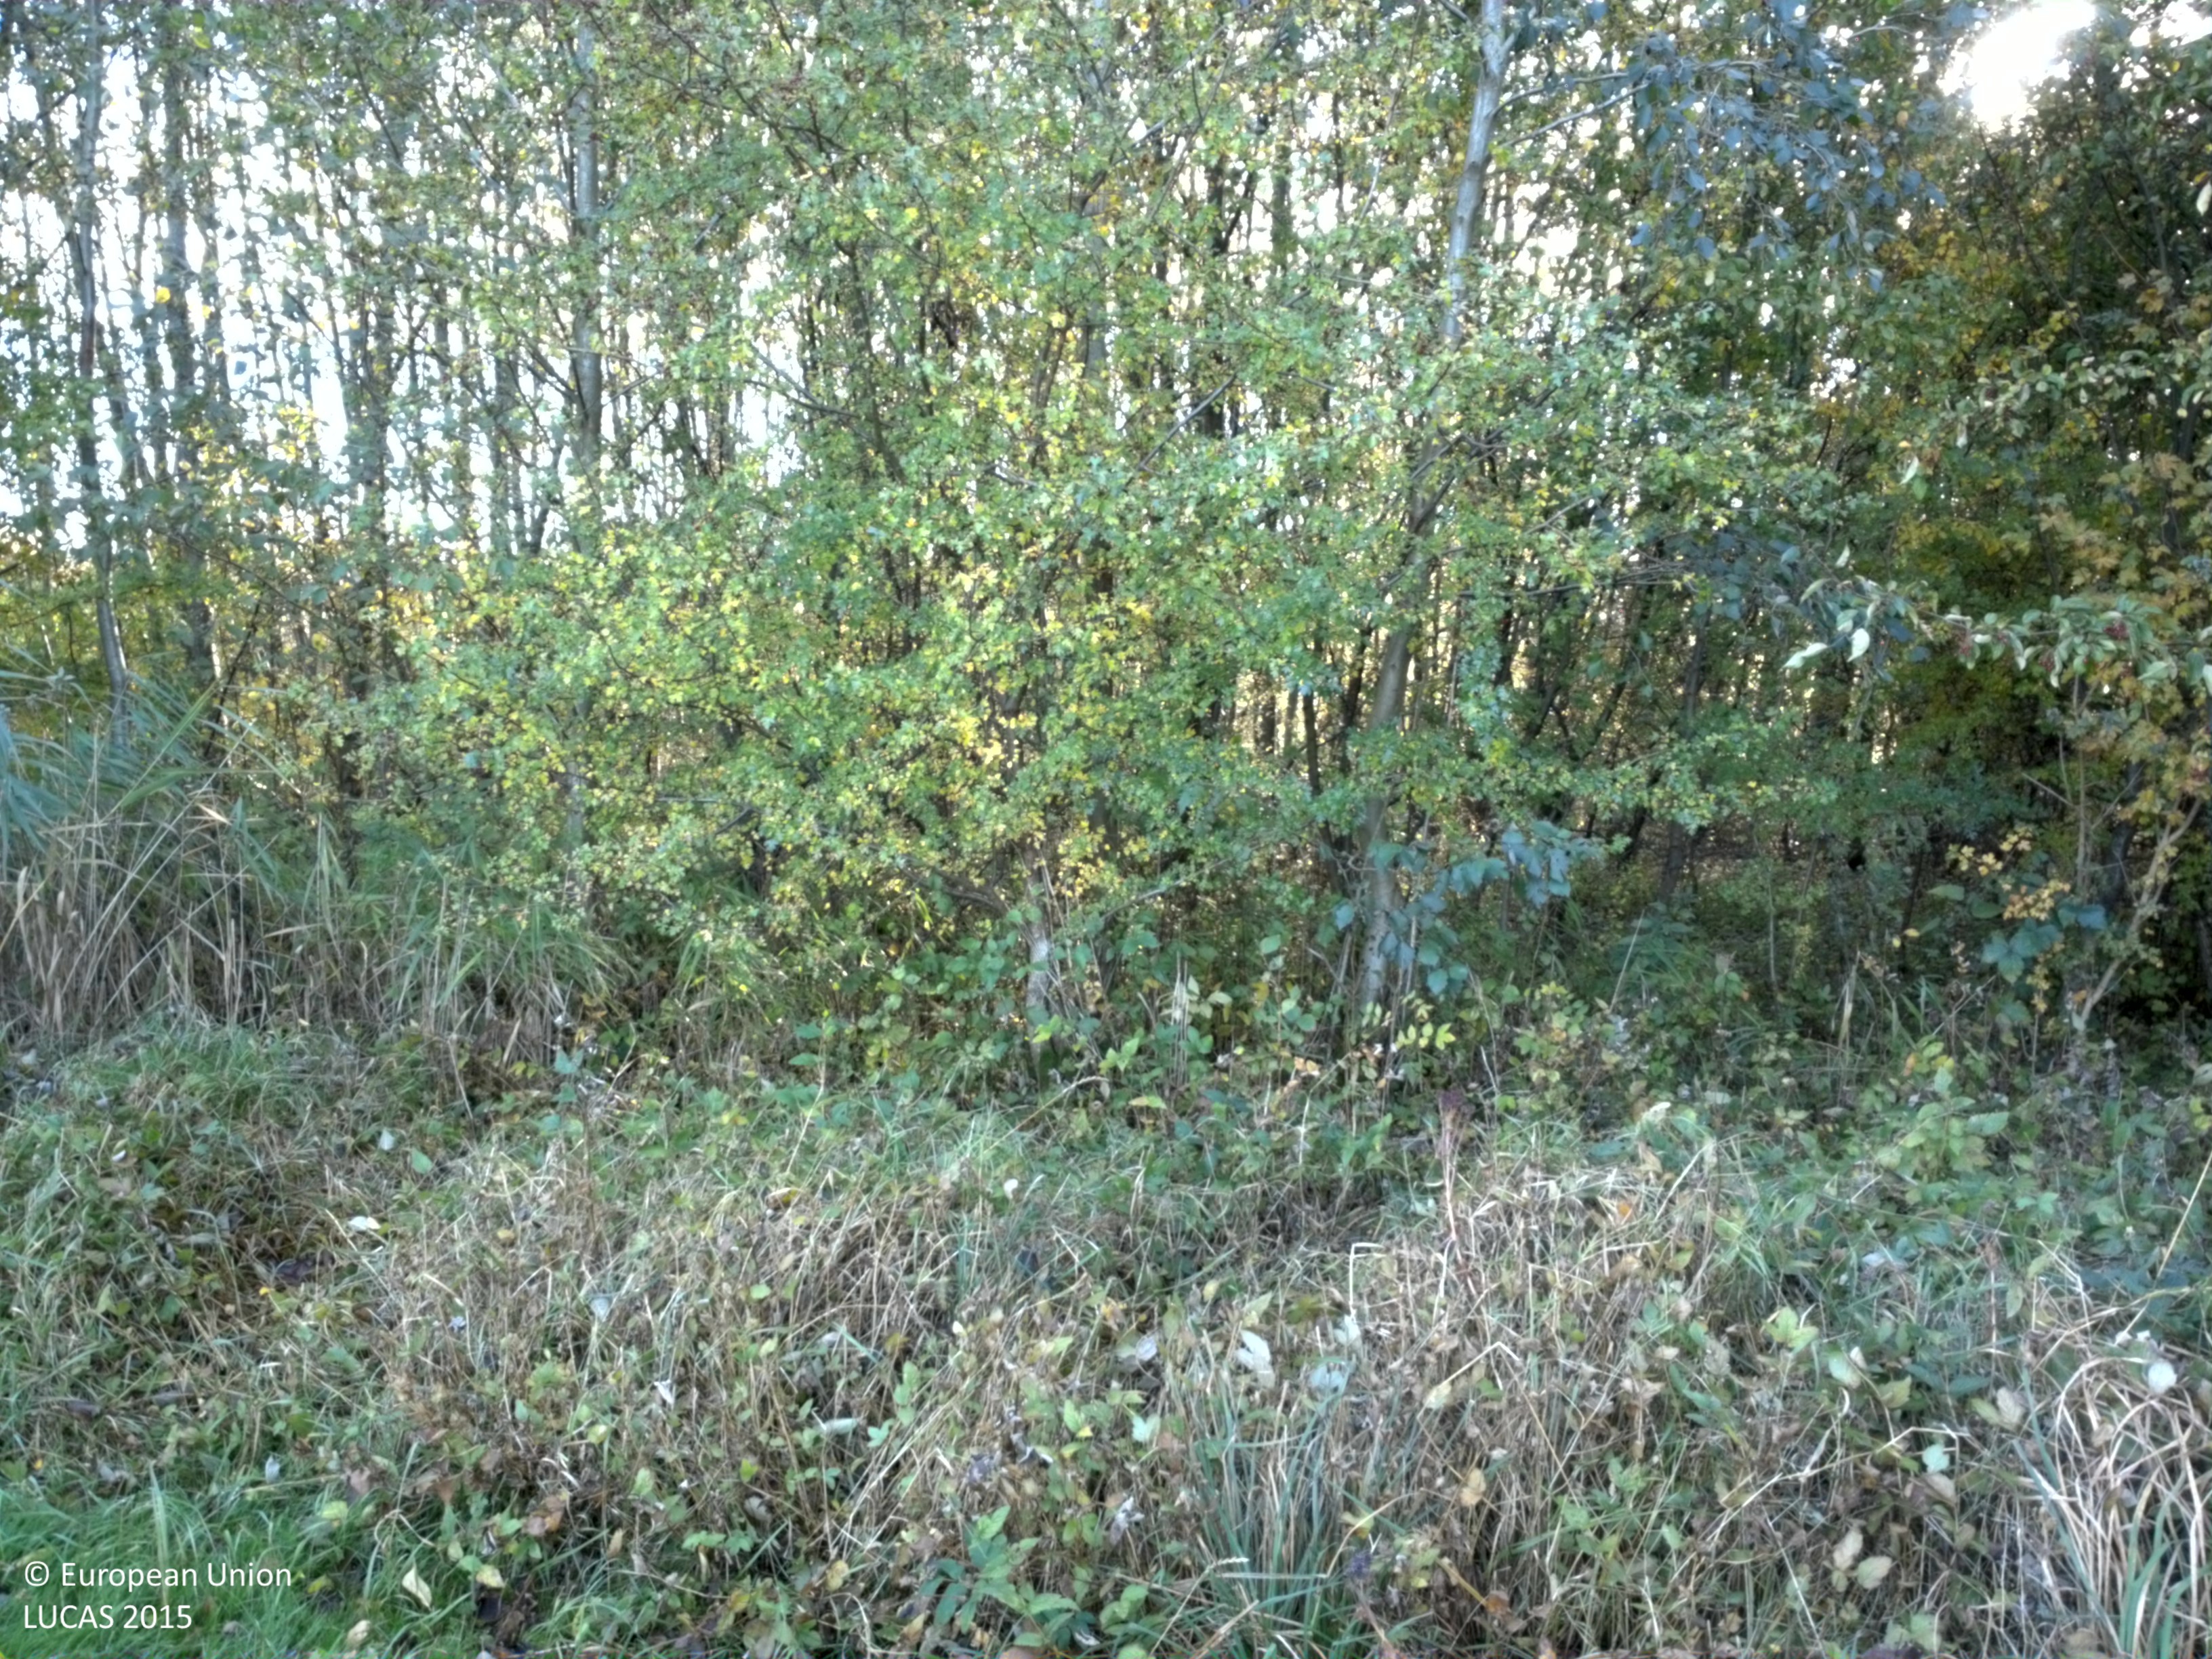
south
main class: Grassland
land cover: Grassland with sparse tree/shrub cover
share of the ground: > 75 %
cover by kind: herbaceous plants 95 %, broadleaved forest trees 5 %
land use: Residential
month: October
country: SE
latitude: 55.9348
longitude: 13.0872
